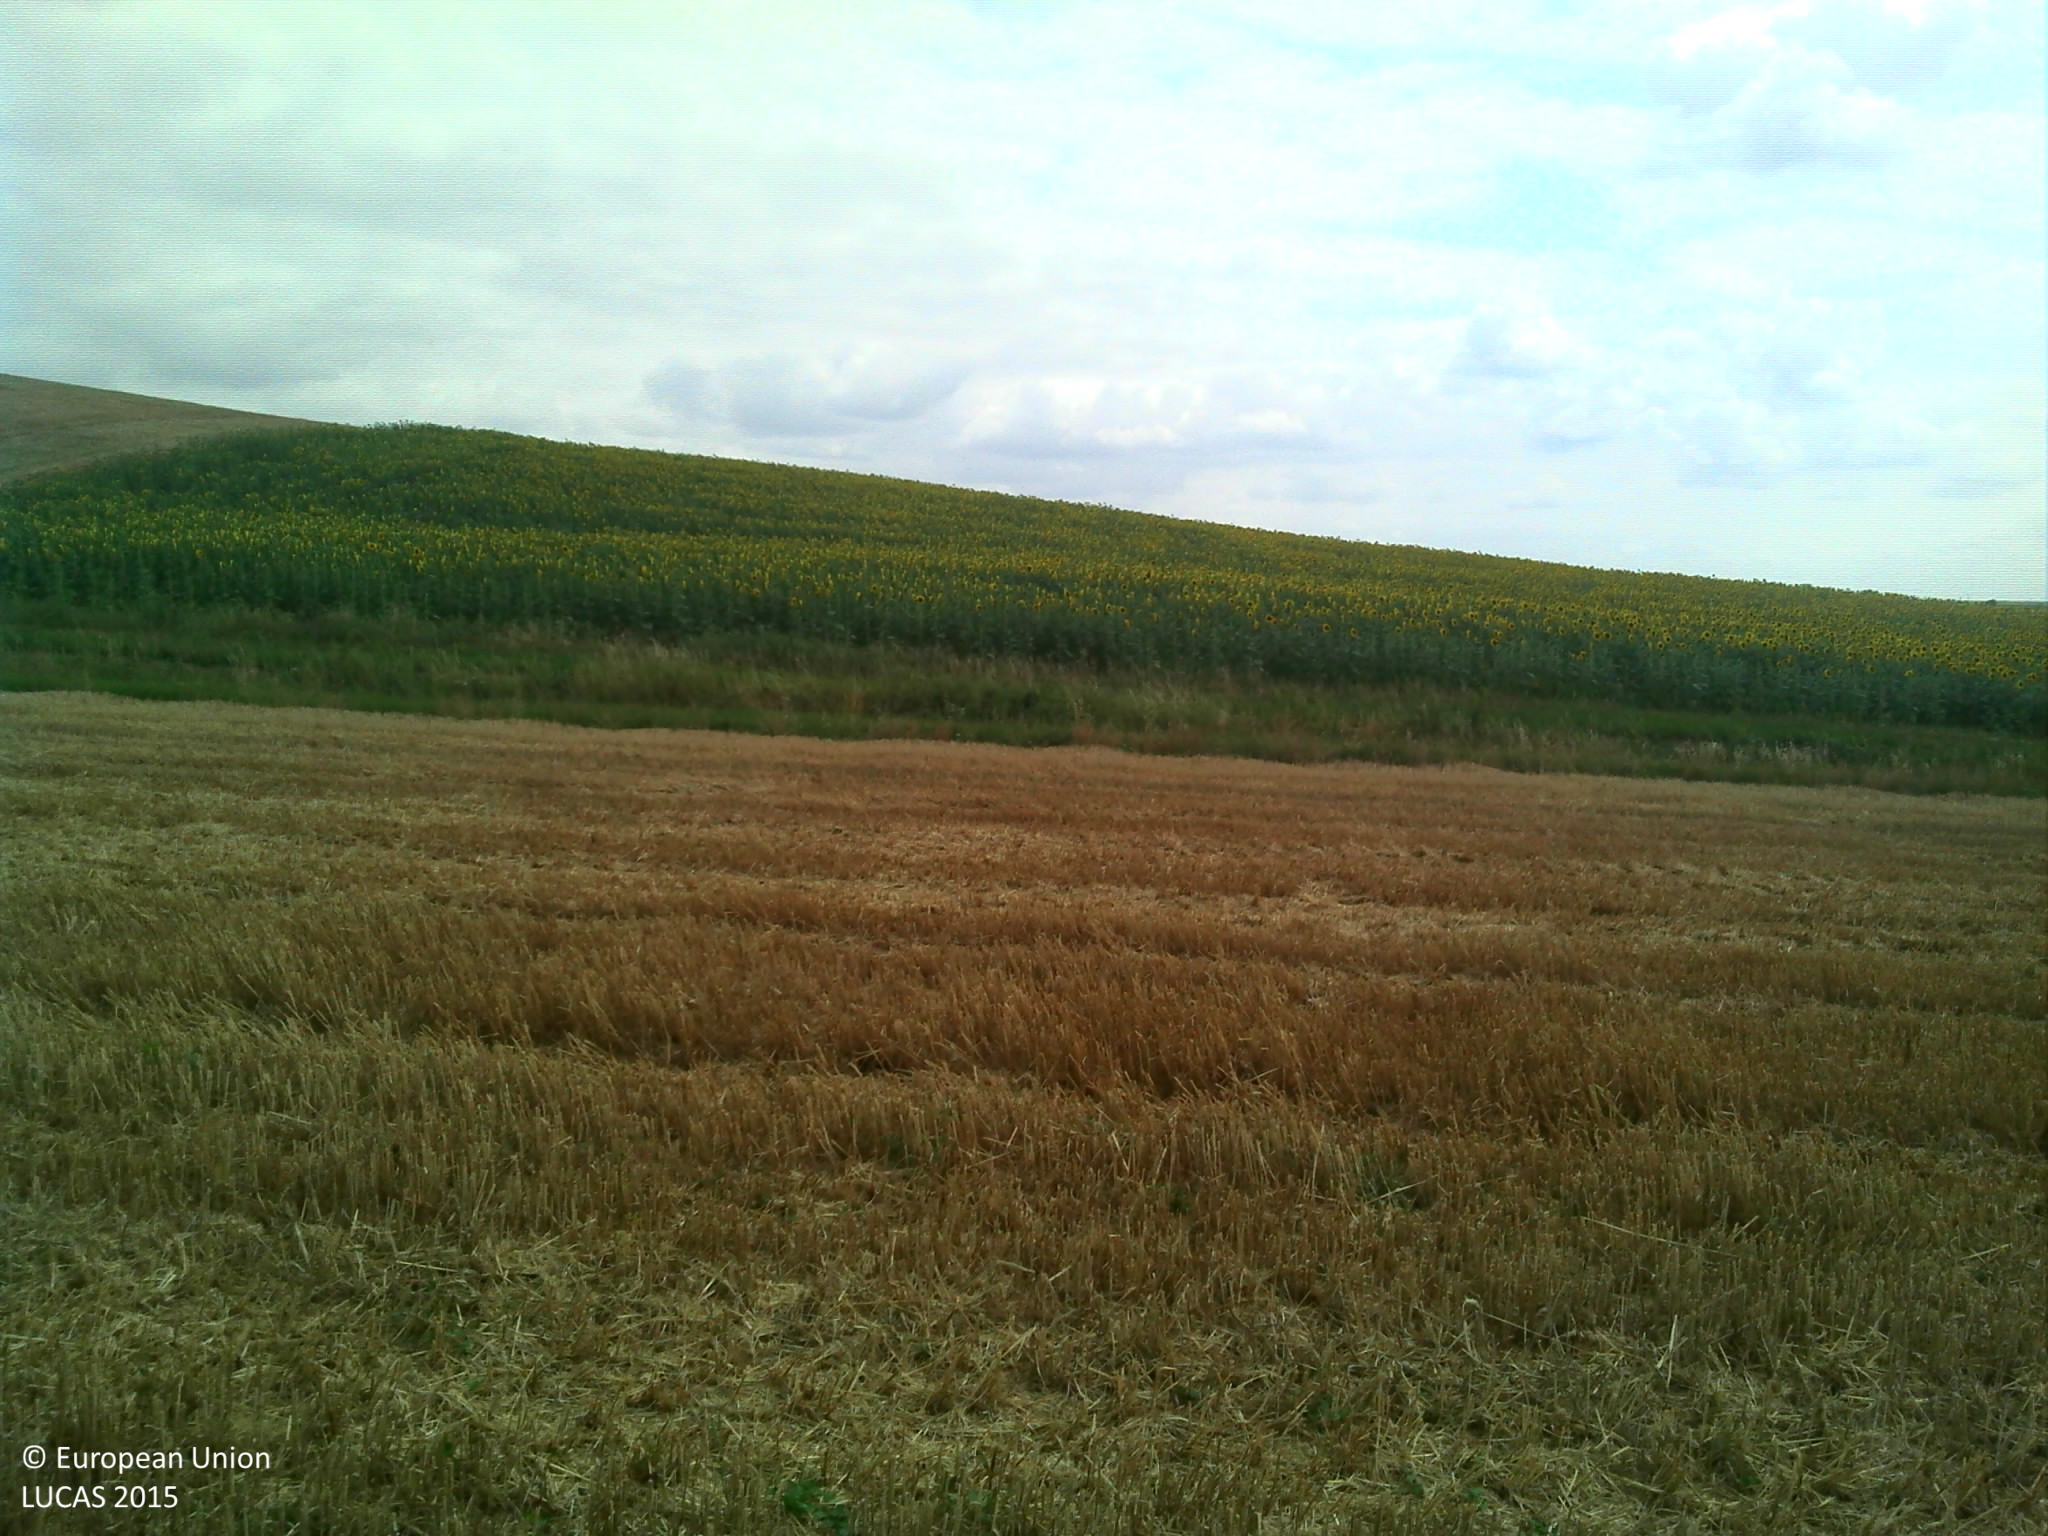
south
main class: Cropland
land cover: Barley
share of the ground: > 75 %
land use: Agriculture (excluding fallow land and kitchen gardens)
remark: Harvested field
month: July
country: FR
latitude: 43.8103
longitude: 0.9614
